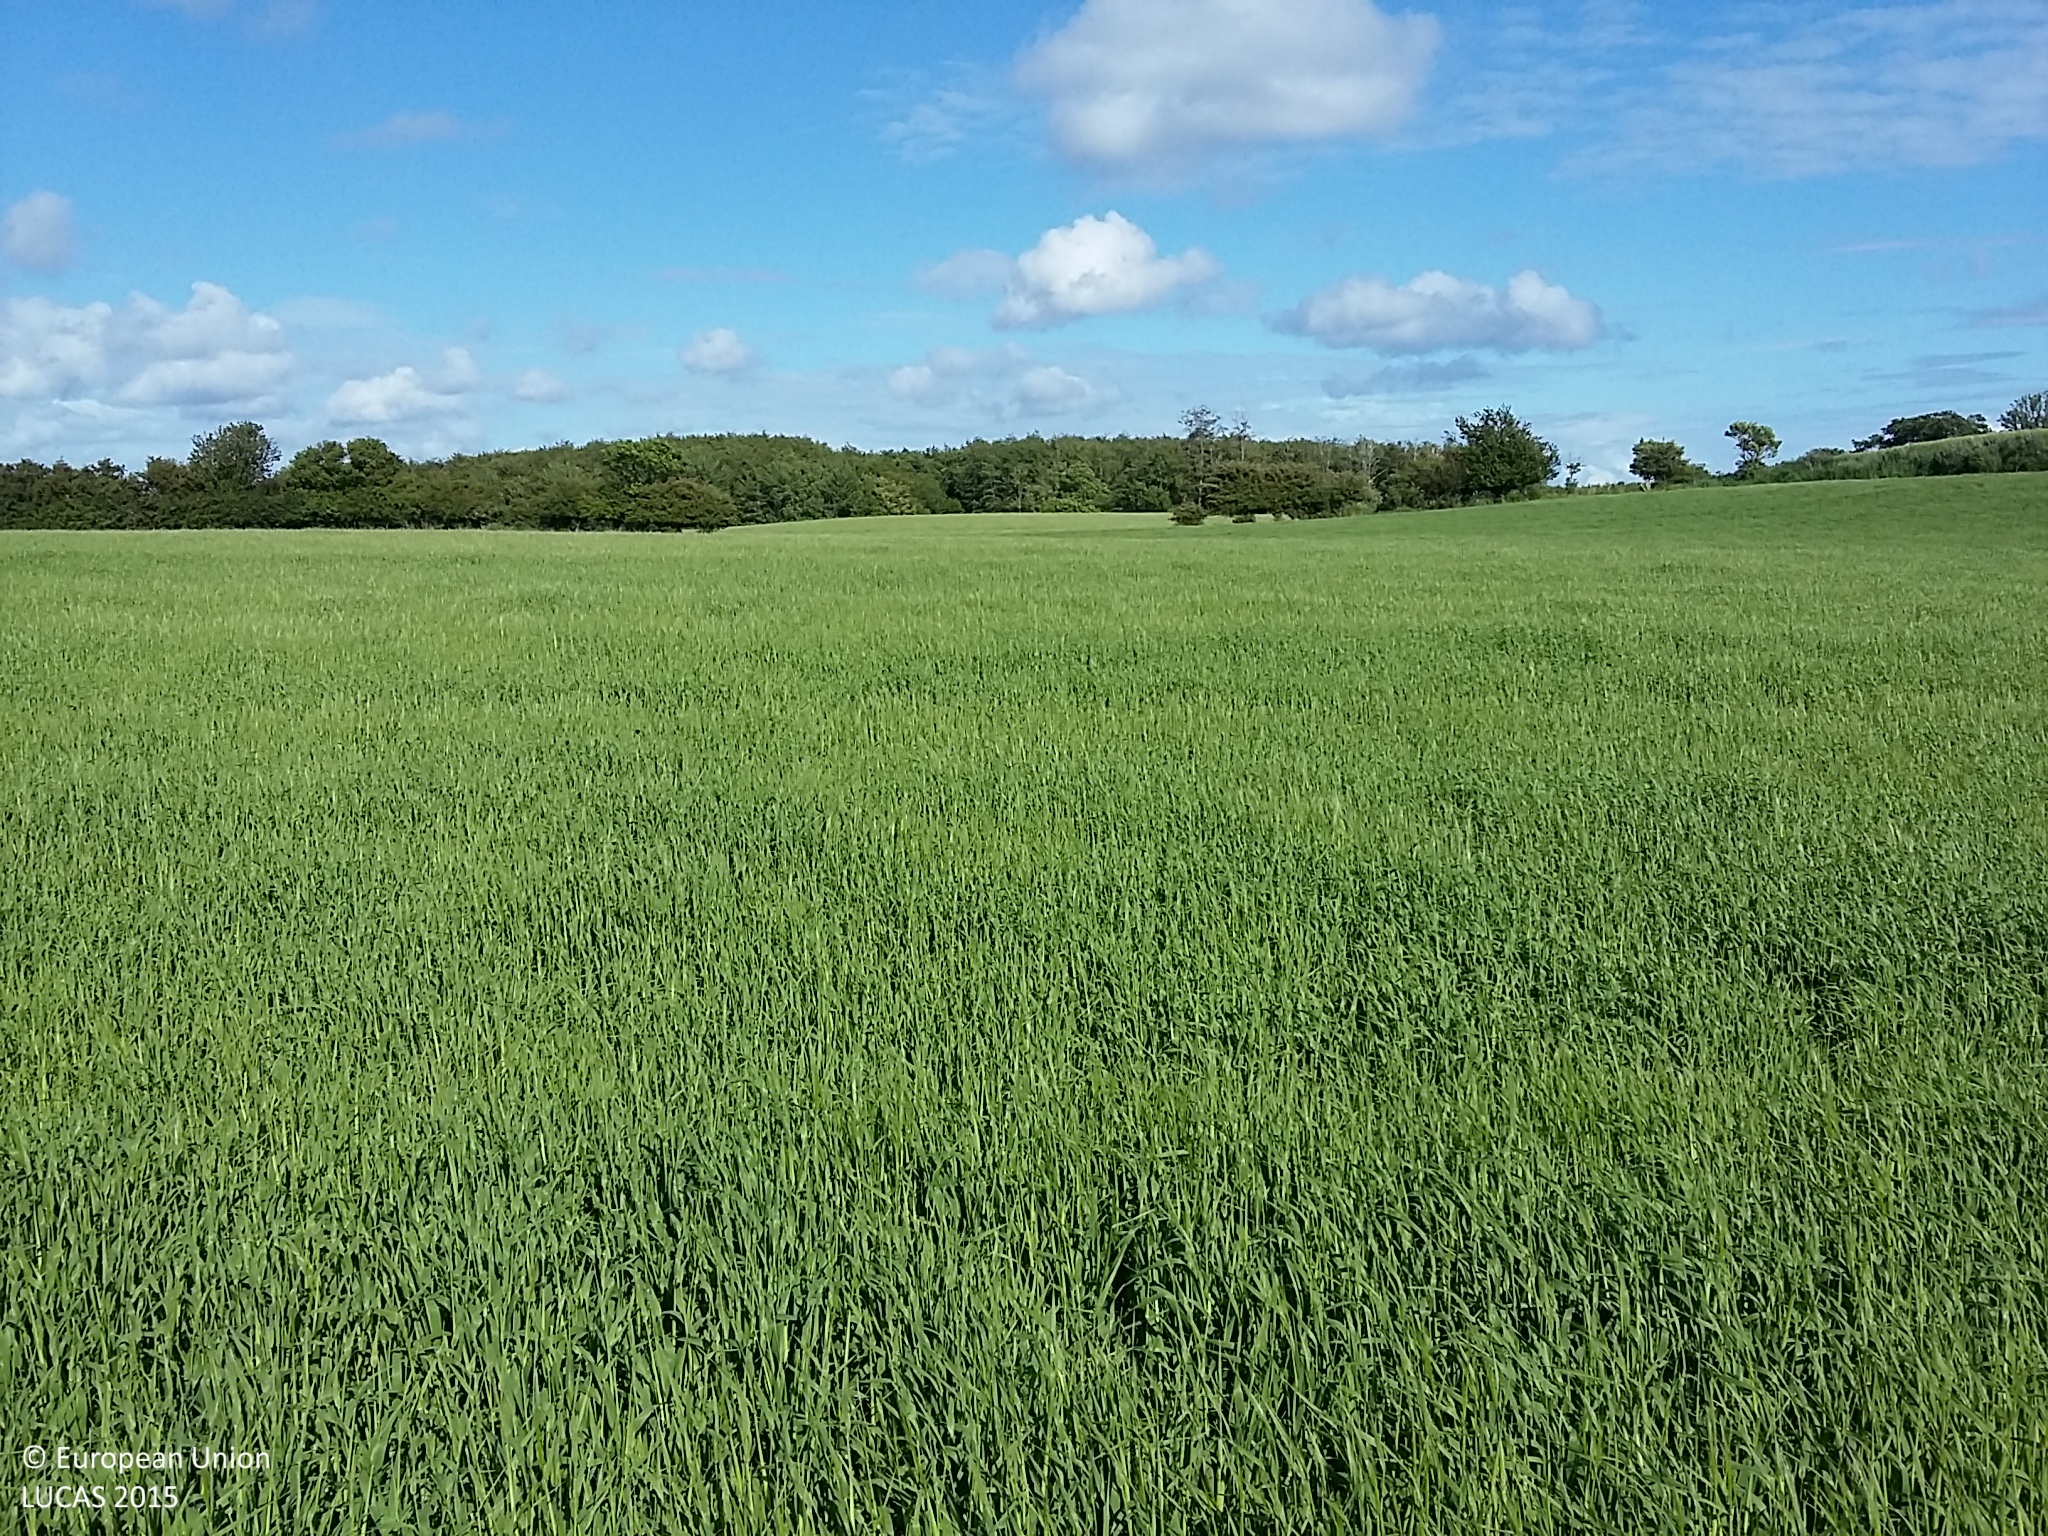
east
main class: Cropland
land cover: Barley
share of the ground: > 75 %
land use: Agriculture (excluding fallow land and kitchen gardens)
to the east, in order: Barley; Managed hedges; Barley
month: June
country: DK
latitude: 54.8374
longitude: 10.7624
